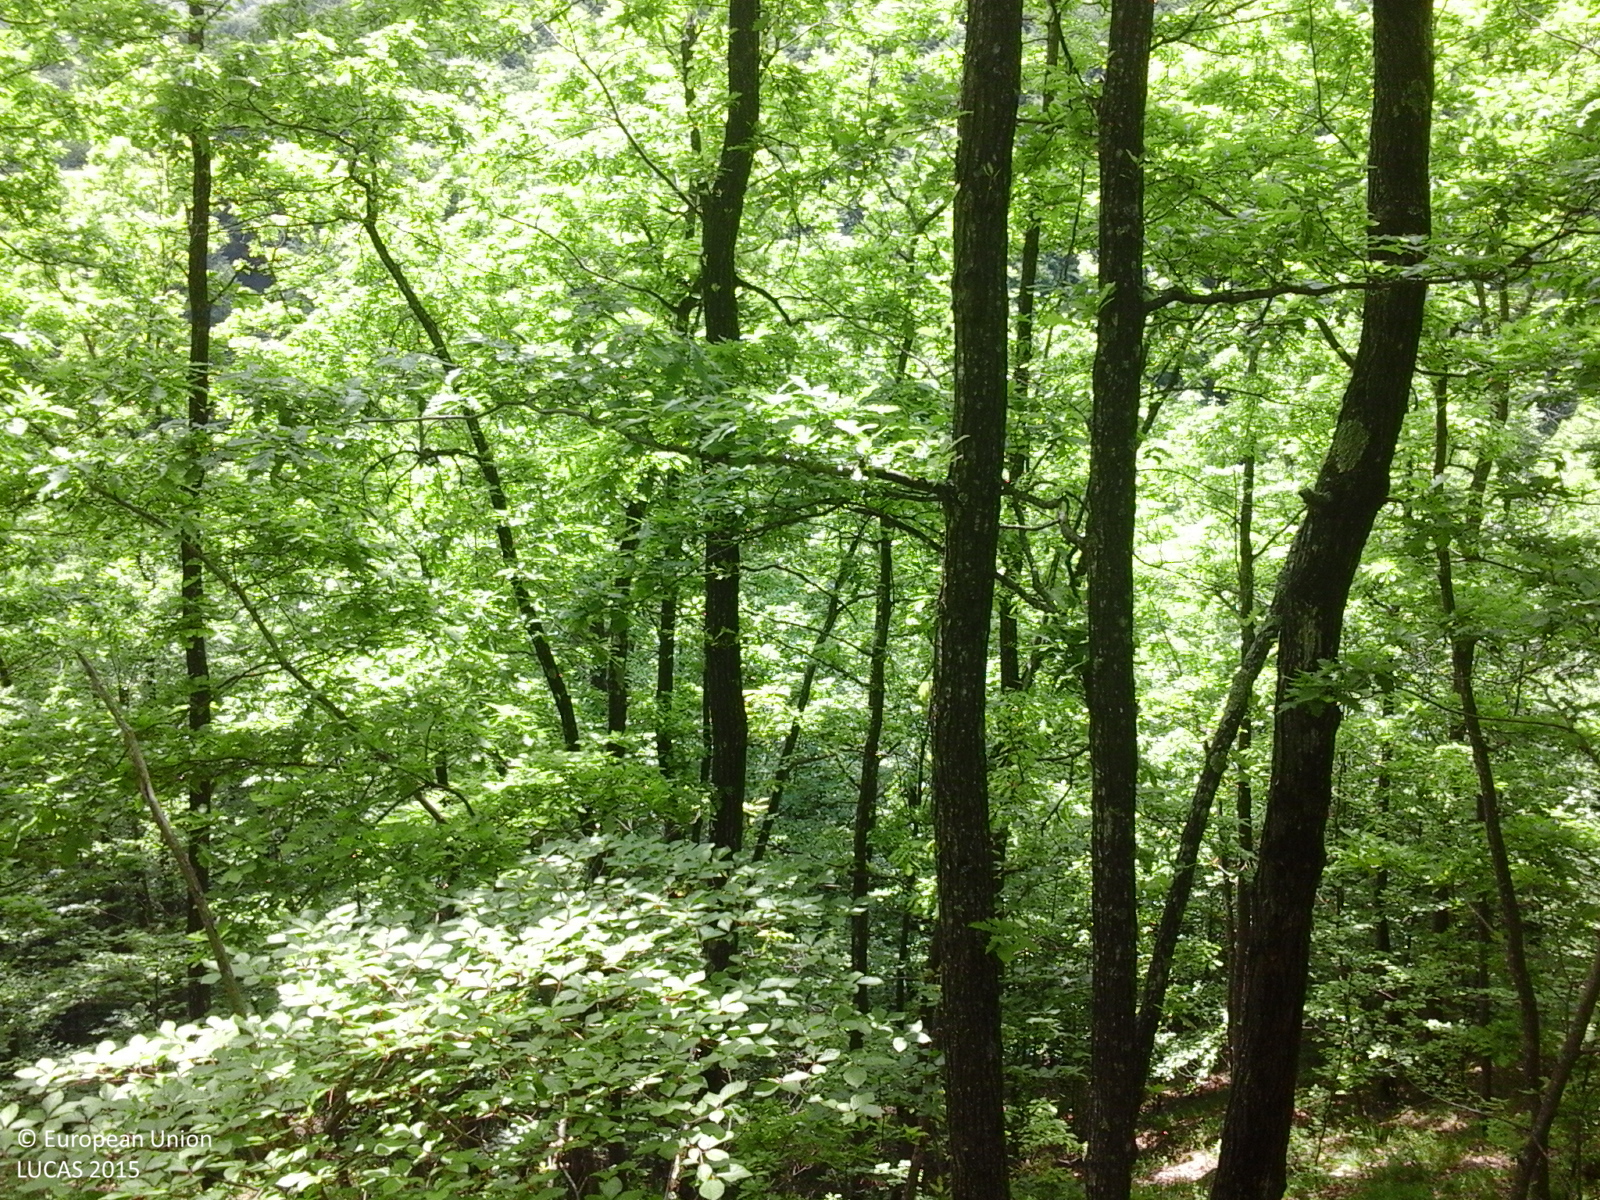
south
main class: Woodland
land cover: Broadleaved woodland
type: acidophilous oak and oak-birch forest
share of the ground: > 75 %
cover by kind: broadleaved forest trees 100 %
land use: Forestry
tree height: > 5 m
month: May
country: RO
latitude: 45.7617
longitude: 25.9937
